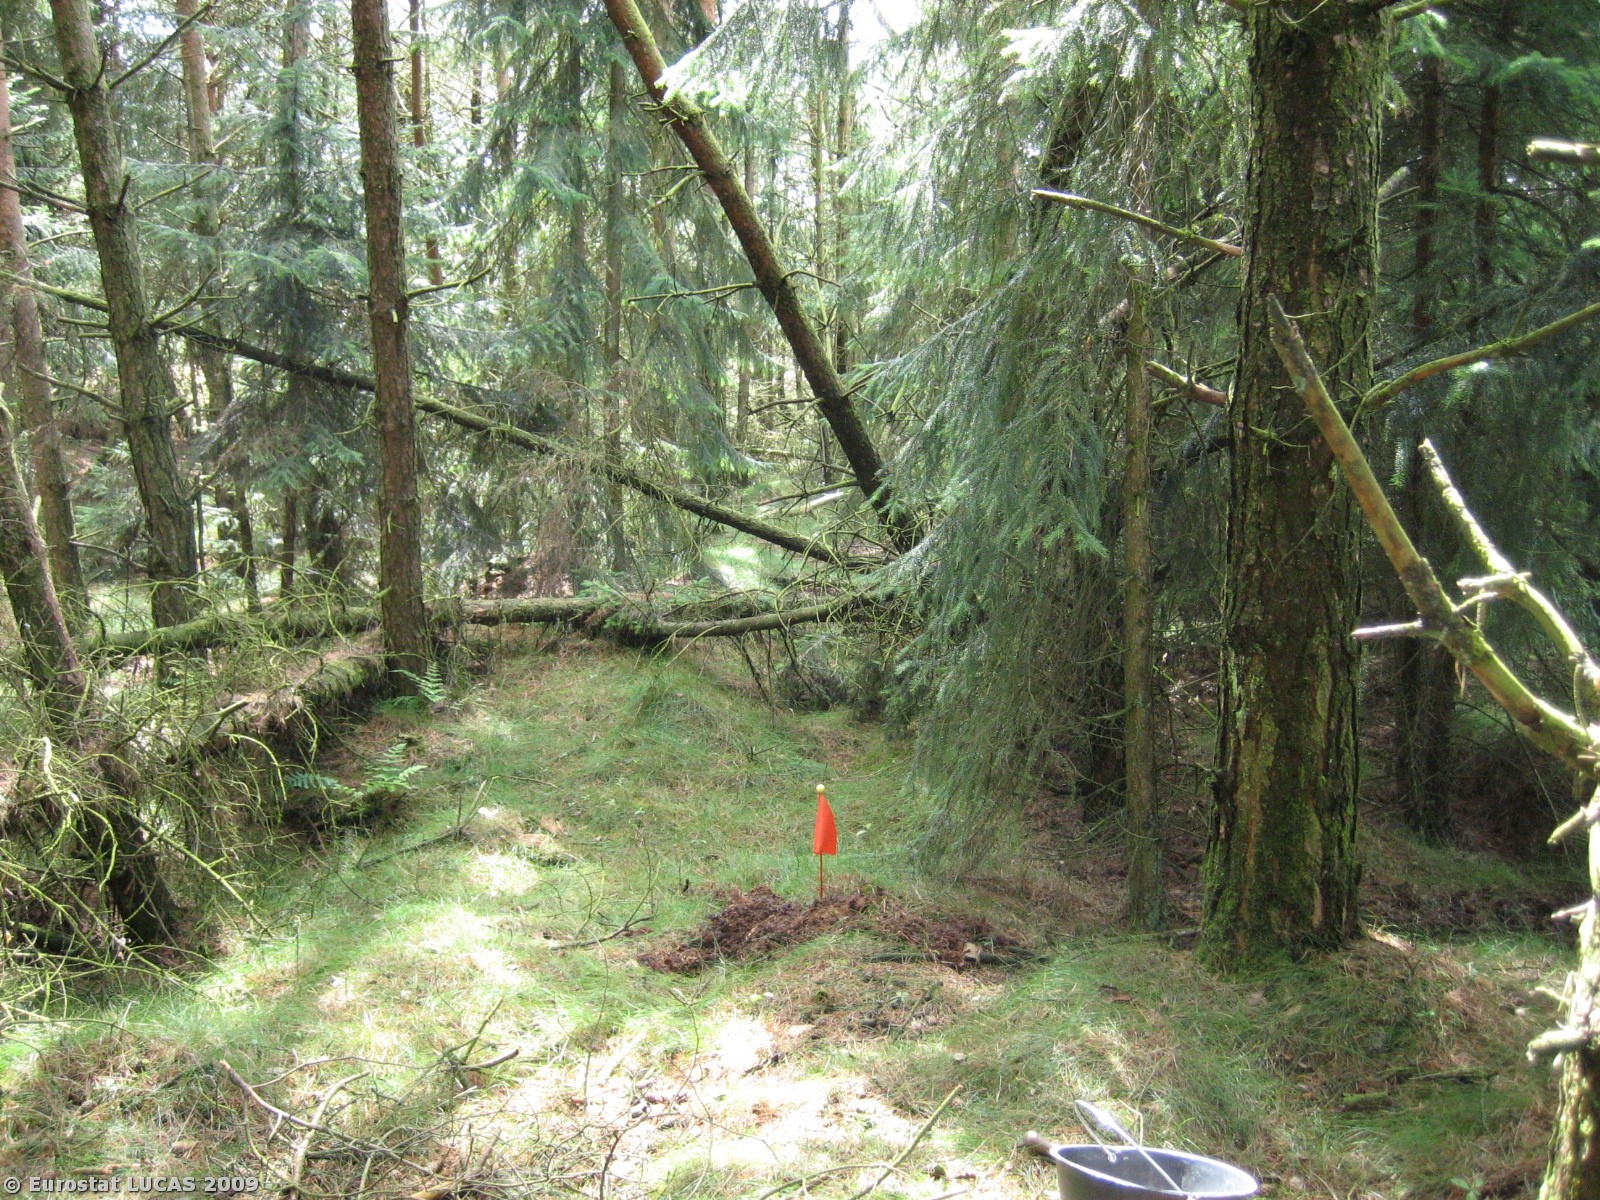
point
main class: Woodland
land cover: Coniferous woodland
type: hemiboreal forest and nemoral coniferous forest and mixed broadleaved-coniferous forest
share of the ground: > 75 %
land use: Forestry
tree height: > 5 m
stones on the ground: < 10 %
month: July
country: DK
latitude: 55.6786
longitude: 8.7767
